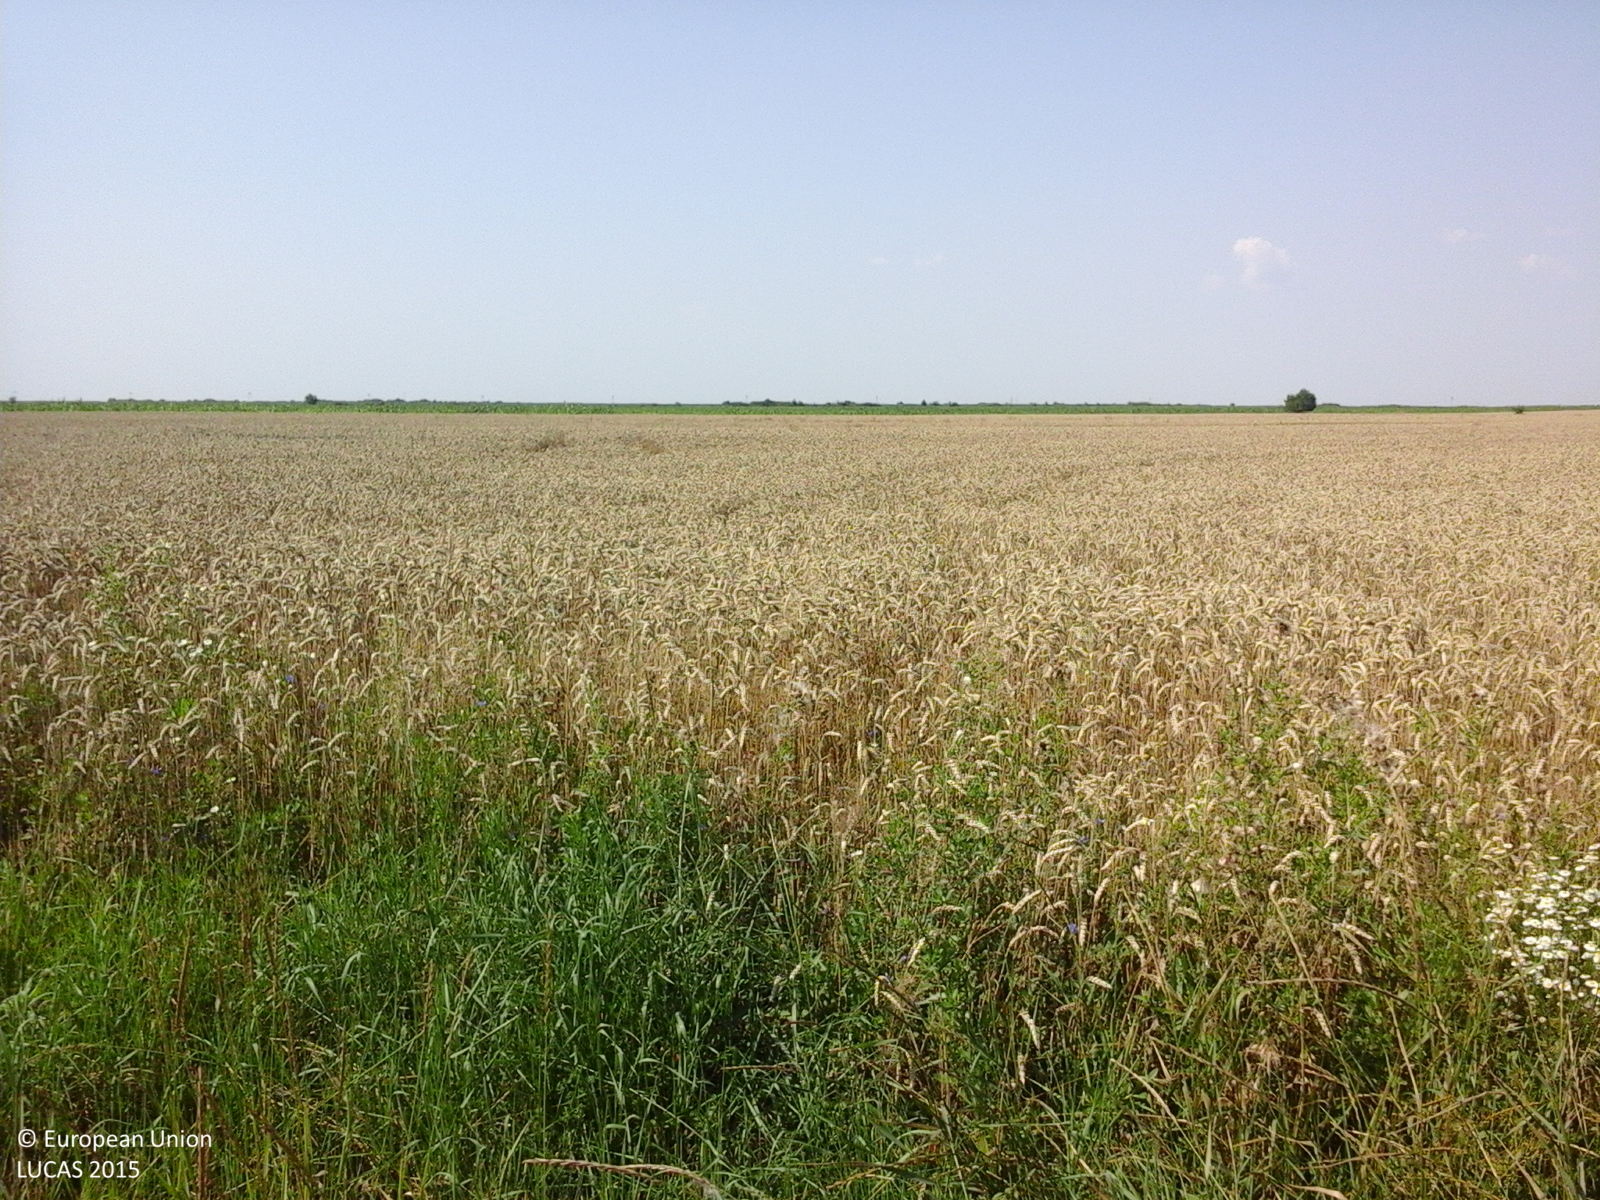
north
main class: Cropland
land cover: Common wheat
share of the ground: > 75 %
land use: Agriculture (excluding fallow land and kitchen gardens)
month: July
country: RO
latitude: 44.5749
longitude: 24.9790
